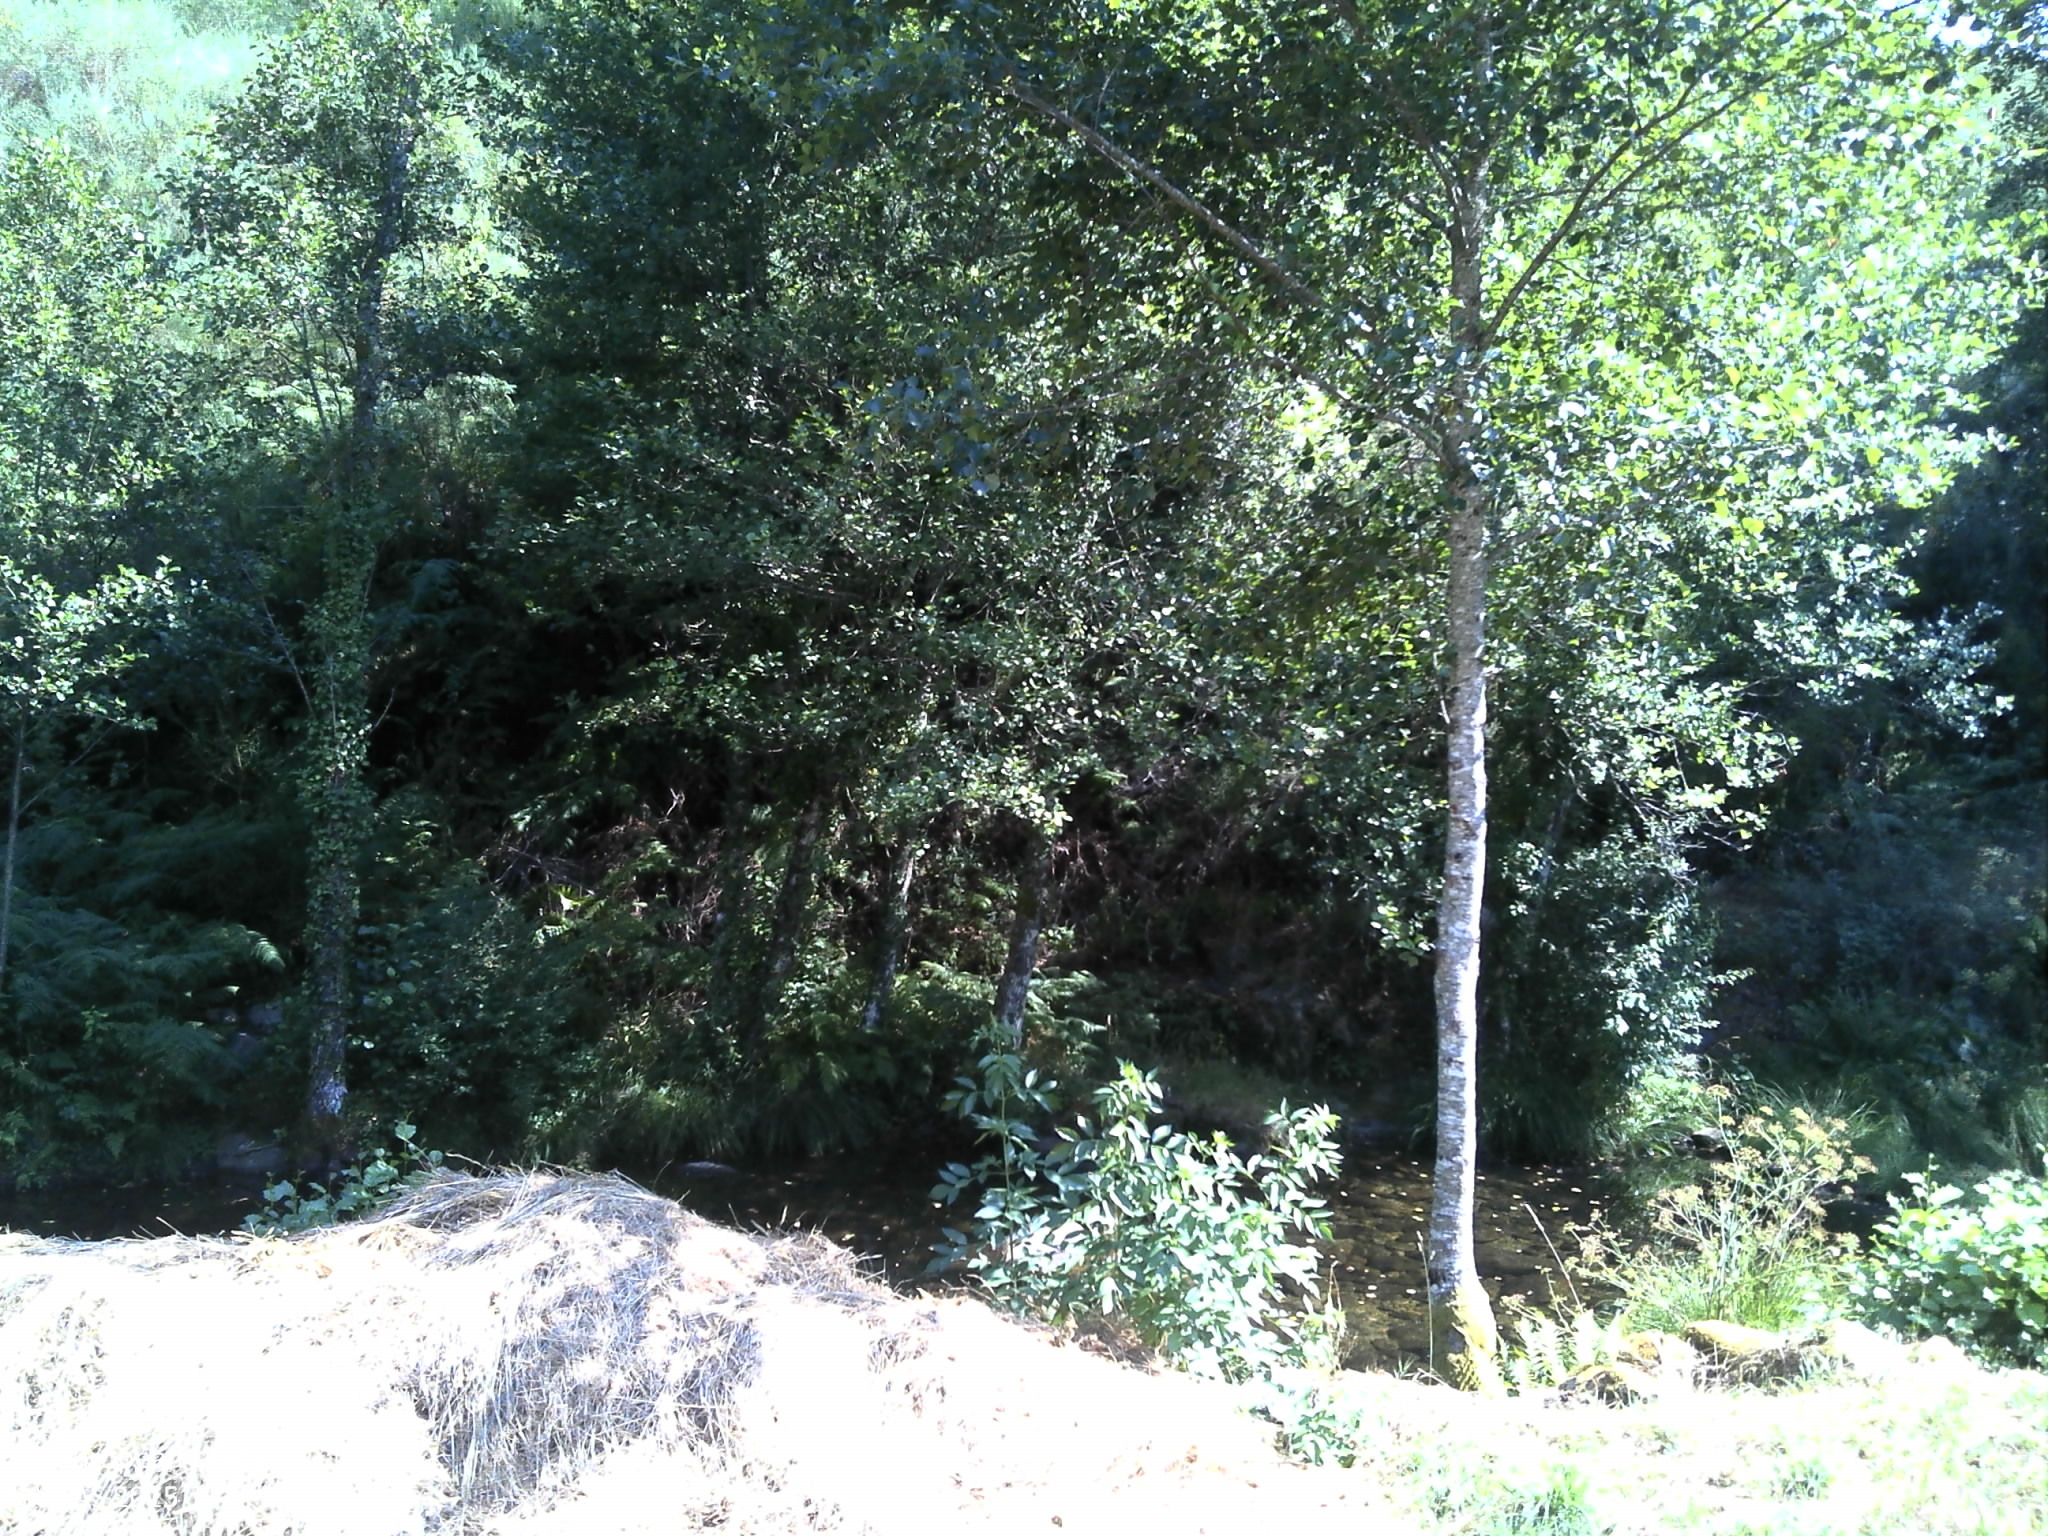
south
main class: Grassland
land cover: Grassland without tree/shrub cover
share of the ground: > 75 %
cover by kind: herbaceous plants 100 %
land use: Agriculture (excluding fallow land and kitchen gardens)
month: July
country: PT
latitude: 40.9053
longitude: -7.8511
